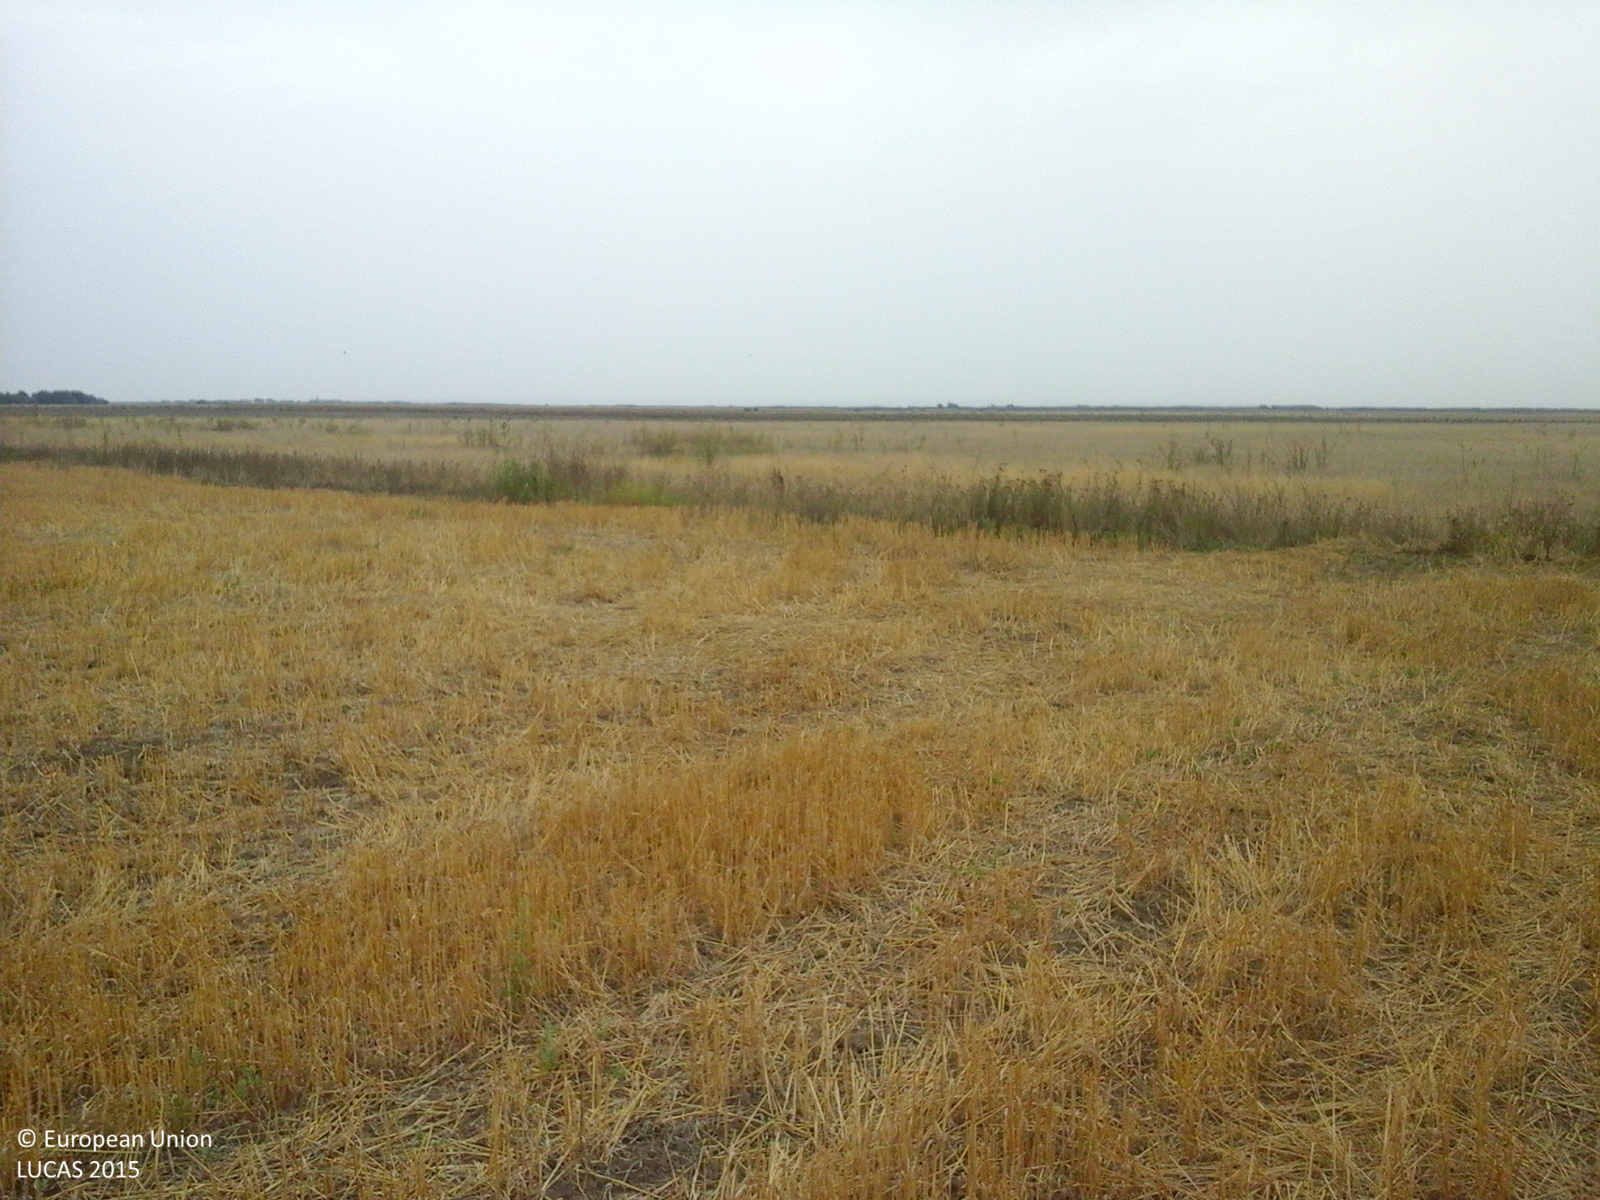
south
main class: Cropland
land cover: Barley
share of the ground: > 75 %
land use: Agriculture (excluding fallow land and kitchen gardens)
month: September
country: RO
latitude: 47.6446
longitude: 22.5854
